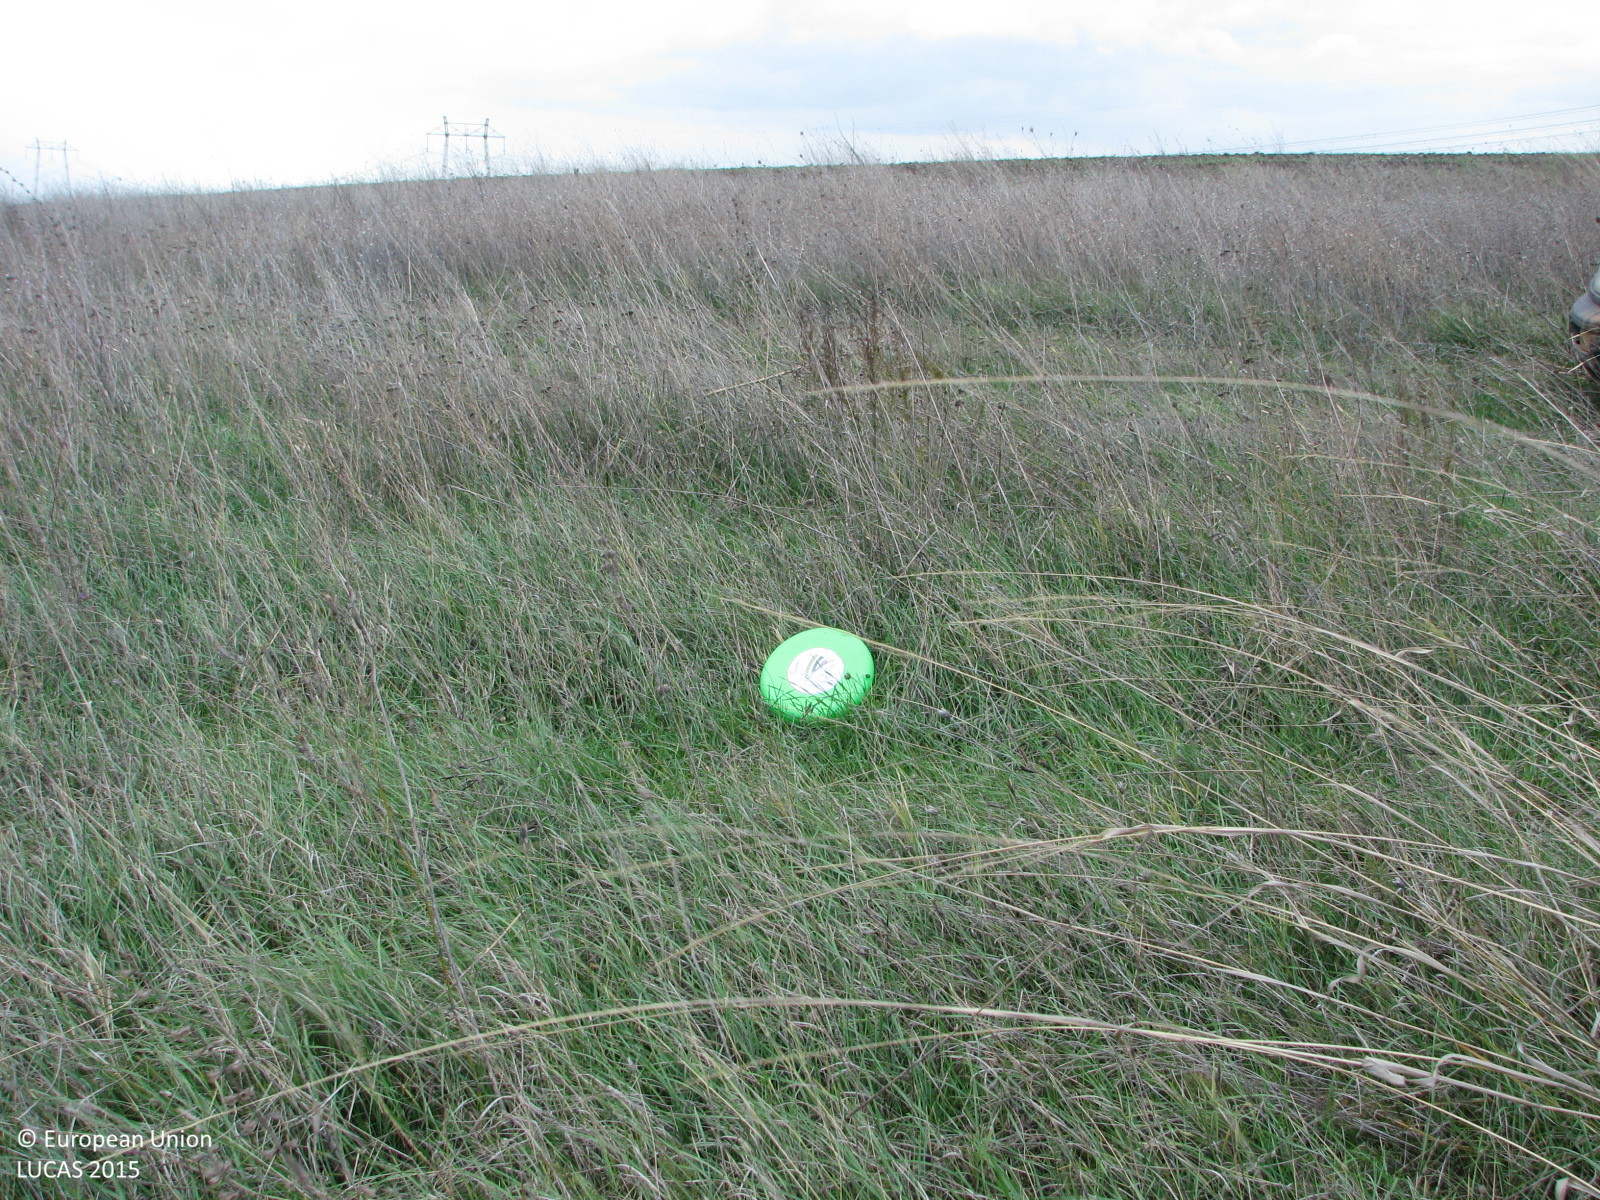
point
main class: Grassland
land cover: Grassland with sparse tree/shrub cover
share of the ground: > 75 %
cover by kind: herbaceous plants 90 %, broadleaved forest trees 5 %, shrubs 5 %
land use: Semi-natural and natural areas not in use
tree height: < 5 m
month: October
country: BG
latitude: 42.2304
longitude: 26.7056
